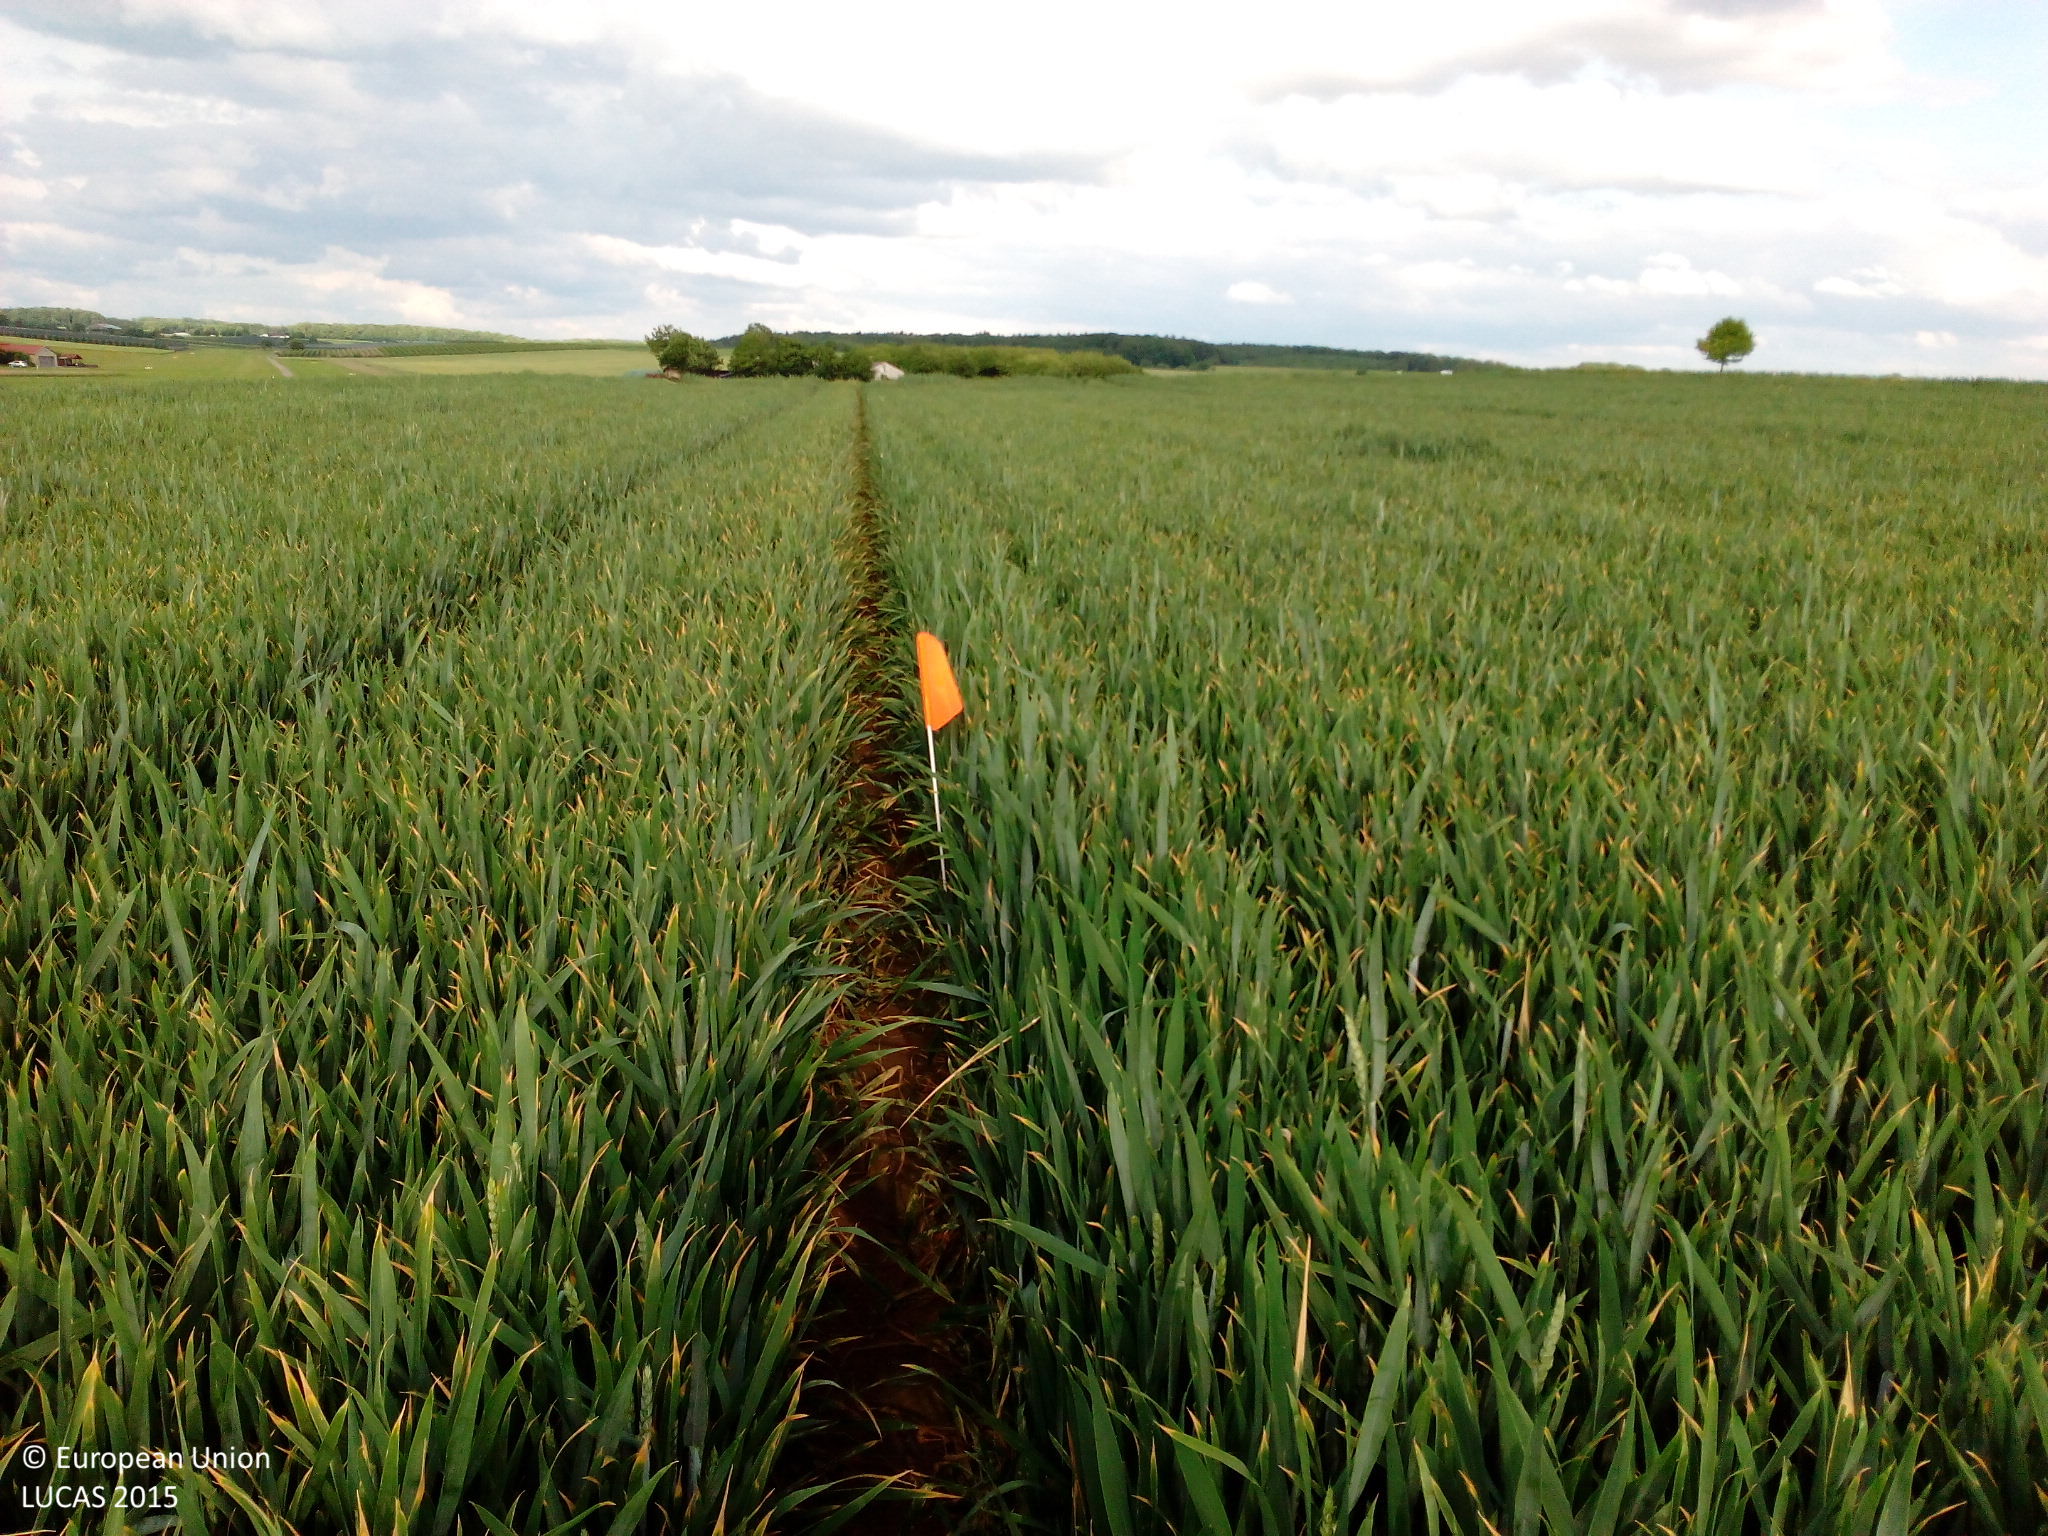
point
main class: Cropland
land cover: Common wheat
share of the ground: > 75 %
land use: Agriculture (excluding fallow land and kitchen gardens)
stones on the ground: < 10 %
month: May
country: DE
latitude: 49.2295
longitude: 9.4098
